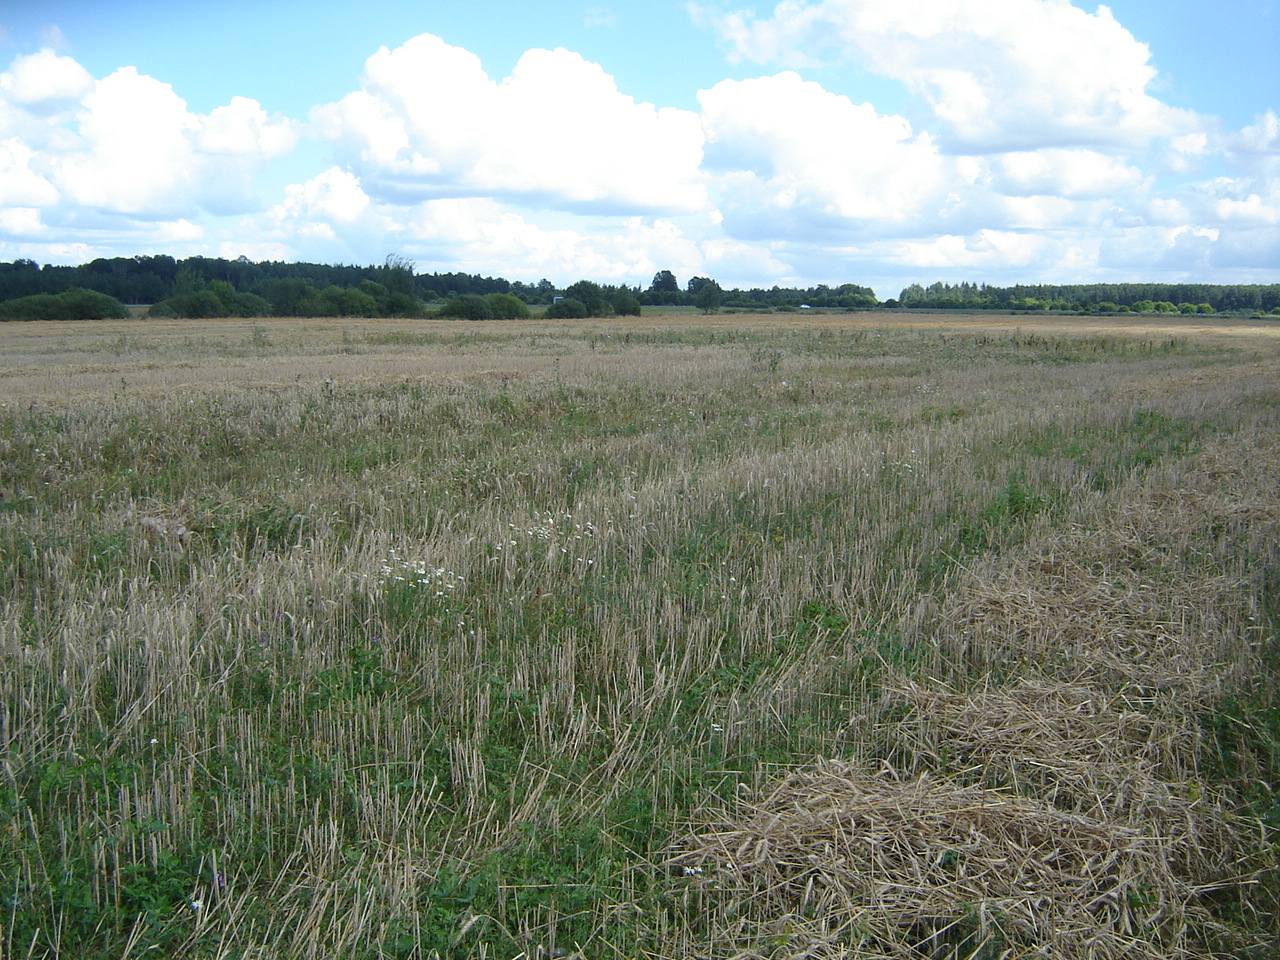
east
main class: Cropland
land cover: Durum wheat
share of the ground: > 75 %
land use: Agriculture (excluding fallow land and kitchen gardens)
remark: Harvested field
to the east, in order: Durum wheat
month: August
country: LT
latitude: 54.9975
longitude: 24.9150
